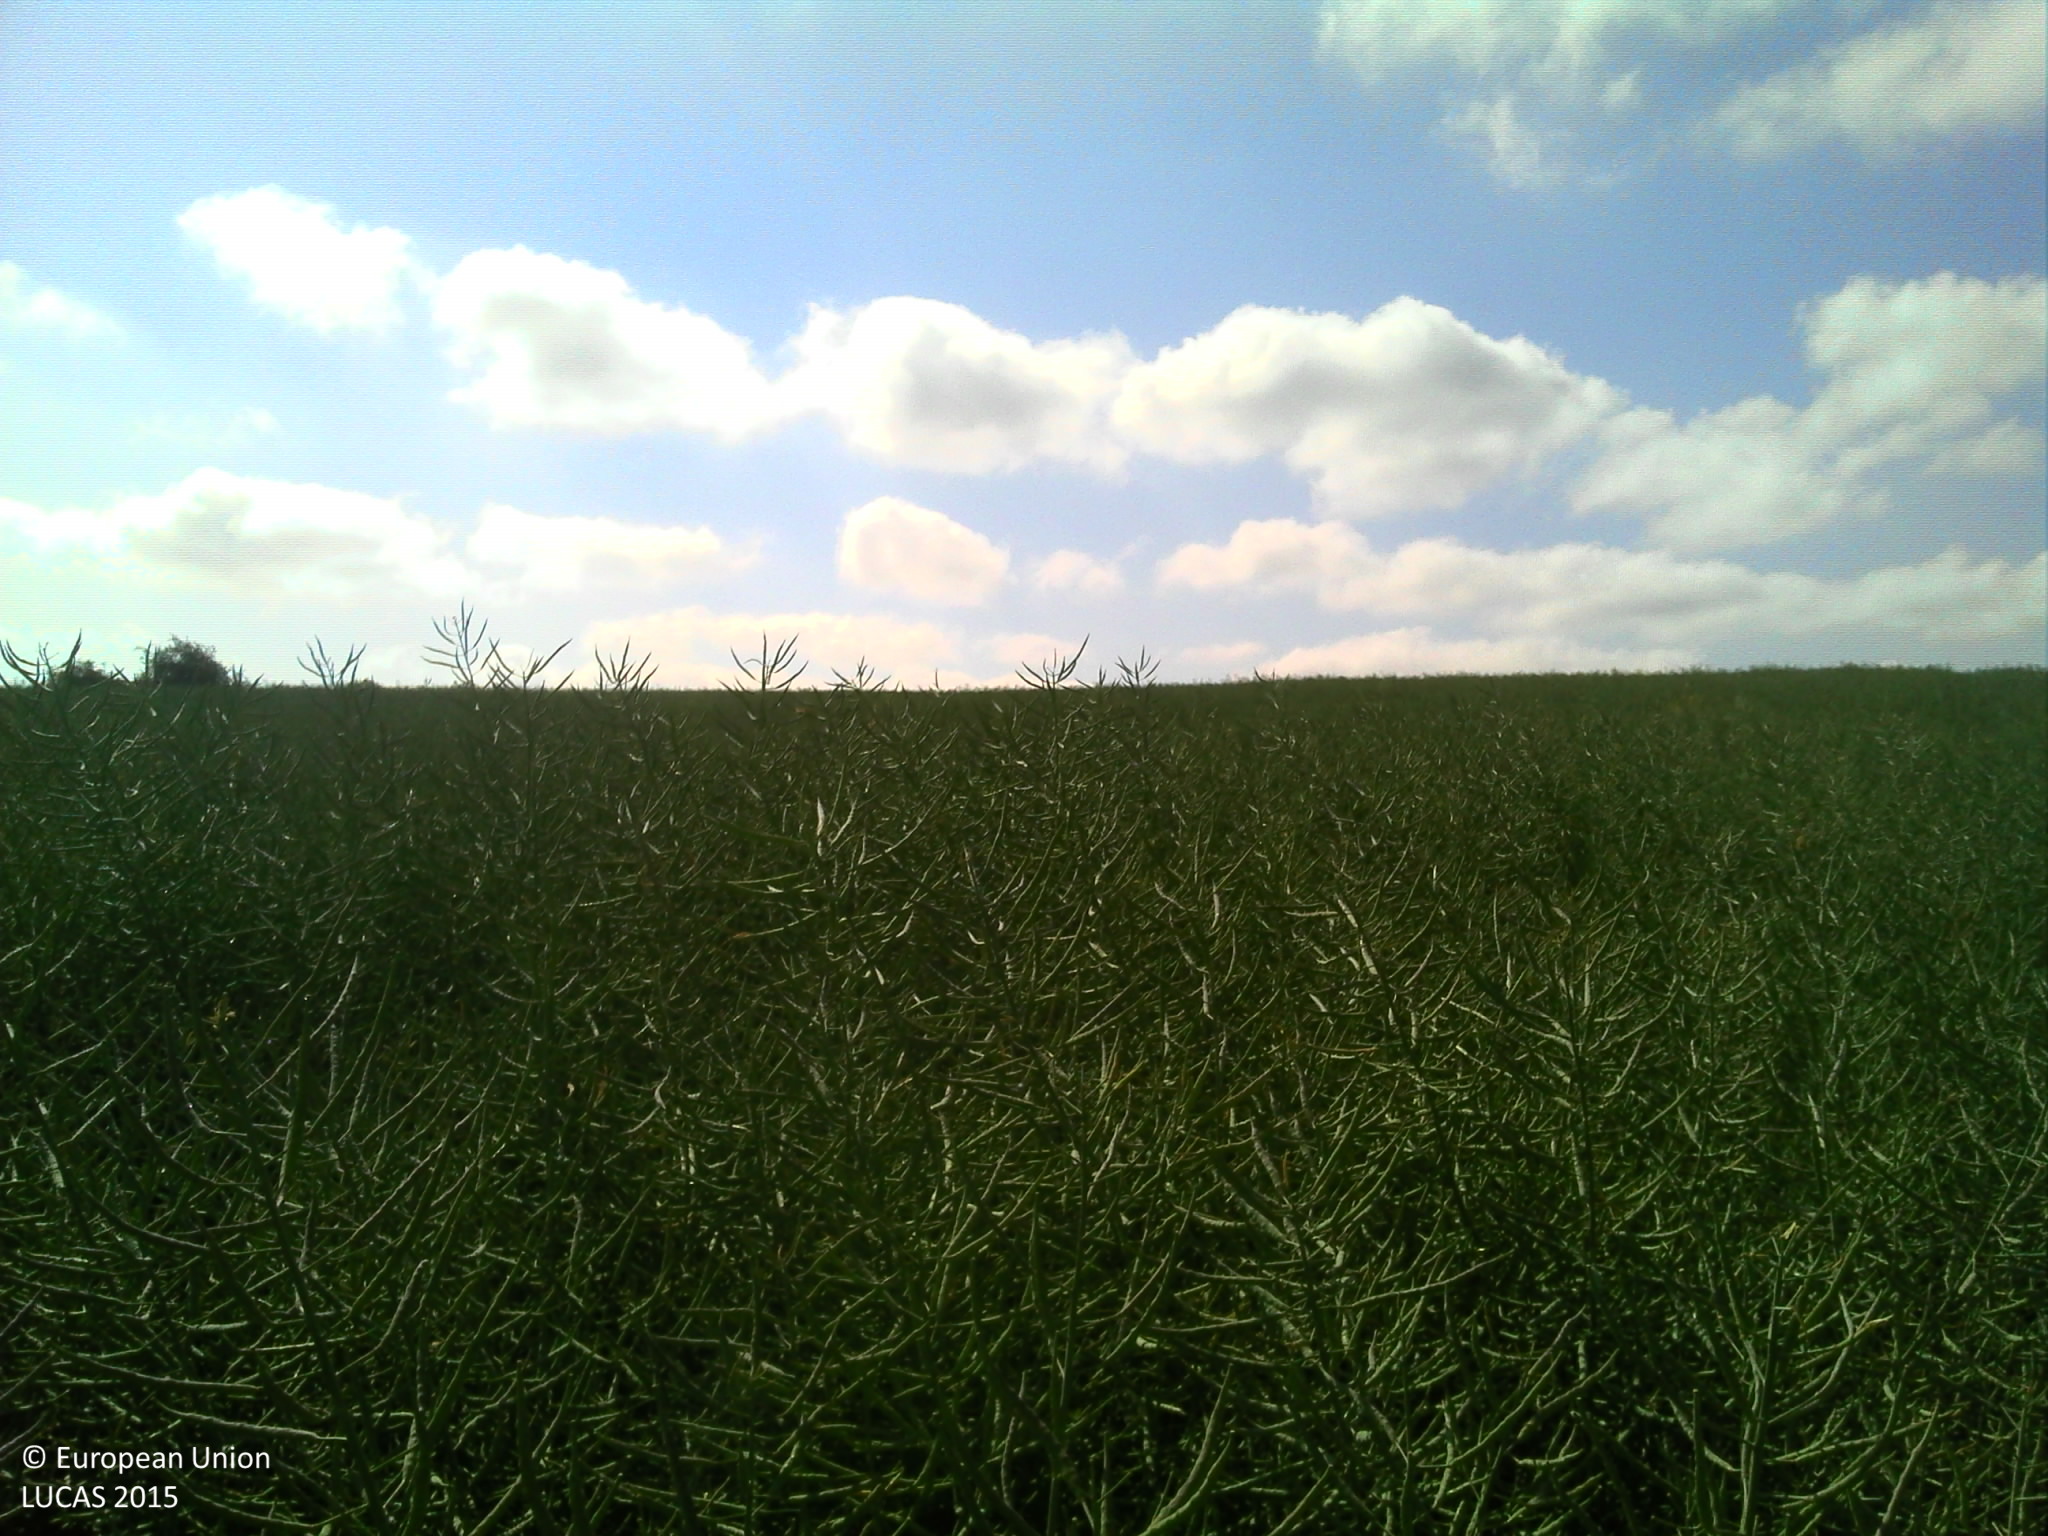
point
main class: Cropland
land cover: Rape and turnip rape
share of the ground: > 75 %
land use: Agriculture (excluding fallow land and kitchen gardens)
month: June
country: BE
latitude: 50.4017
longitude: 4.6641
